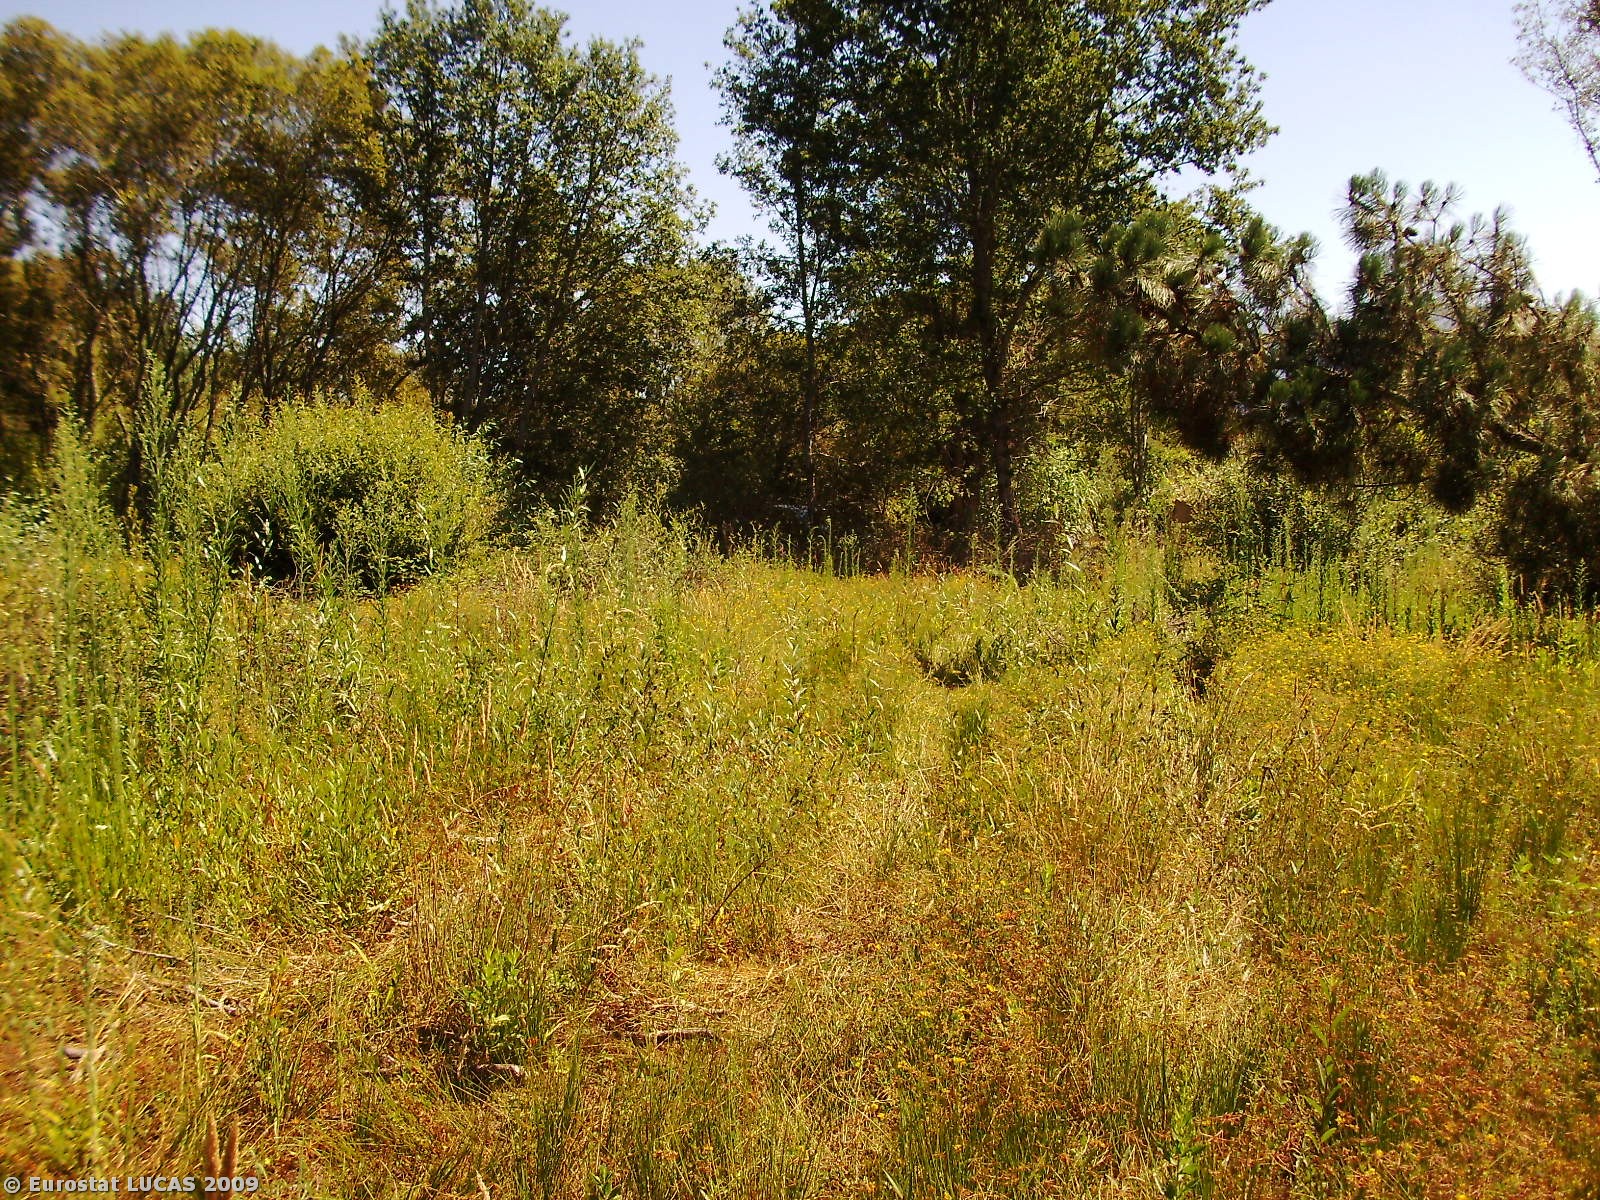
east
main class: Shrubland
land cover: Shrubland with sparse tree cover
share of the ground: > 75 %
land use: Fallow land
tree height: > 5 m
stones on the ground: < 10 %
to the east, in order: Shrubland with sparse tree cover; Tracks; Broadleaved woodland; Shrubland with sparse tree cover; Spontaneously vegetated surfaces; Shrubland with sparse tree cover; Spontaneously vegetated surfaces; Vineyards; Spontaneously vegetated surfaces; Vineyards; Potatoes; Vineyards; Dry pulses; Vineyards; Spontaneously vegetated surfaces; Artificial constructions in urban areas
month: August
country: PT
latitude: 40.1239
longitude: -8.2781
